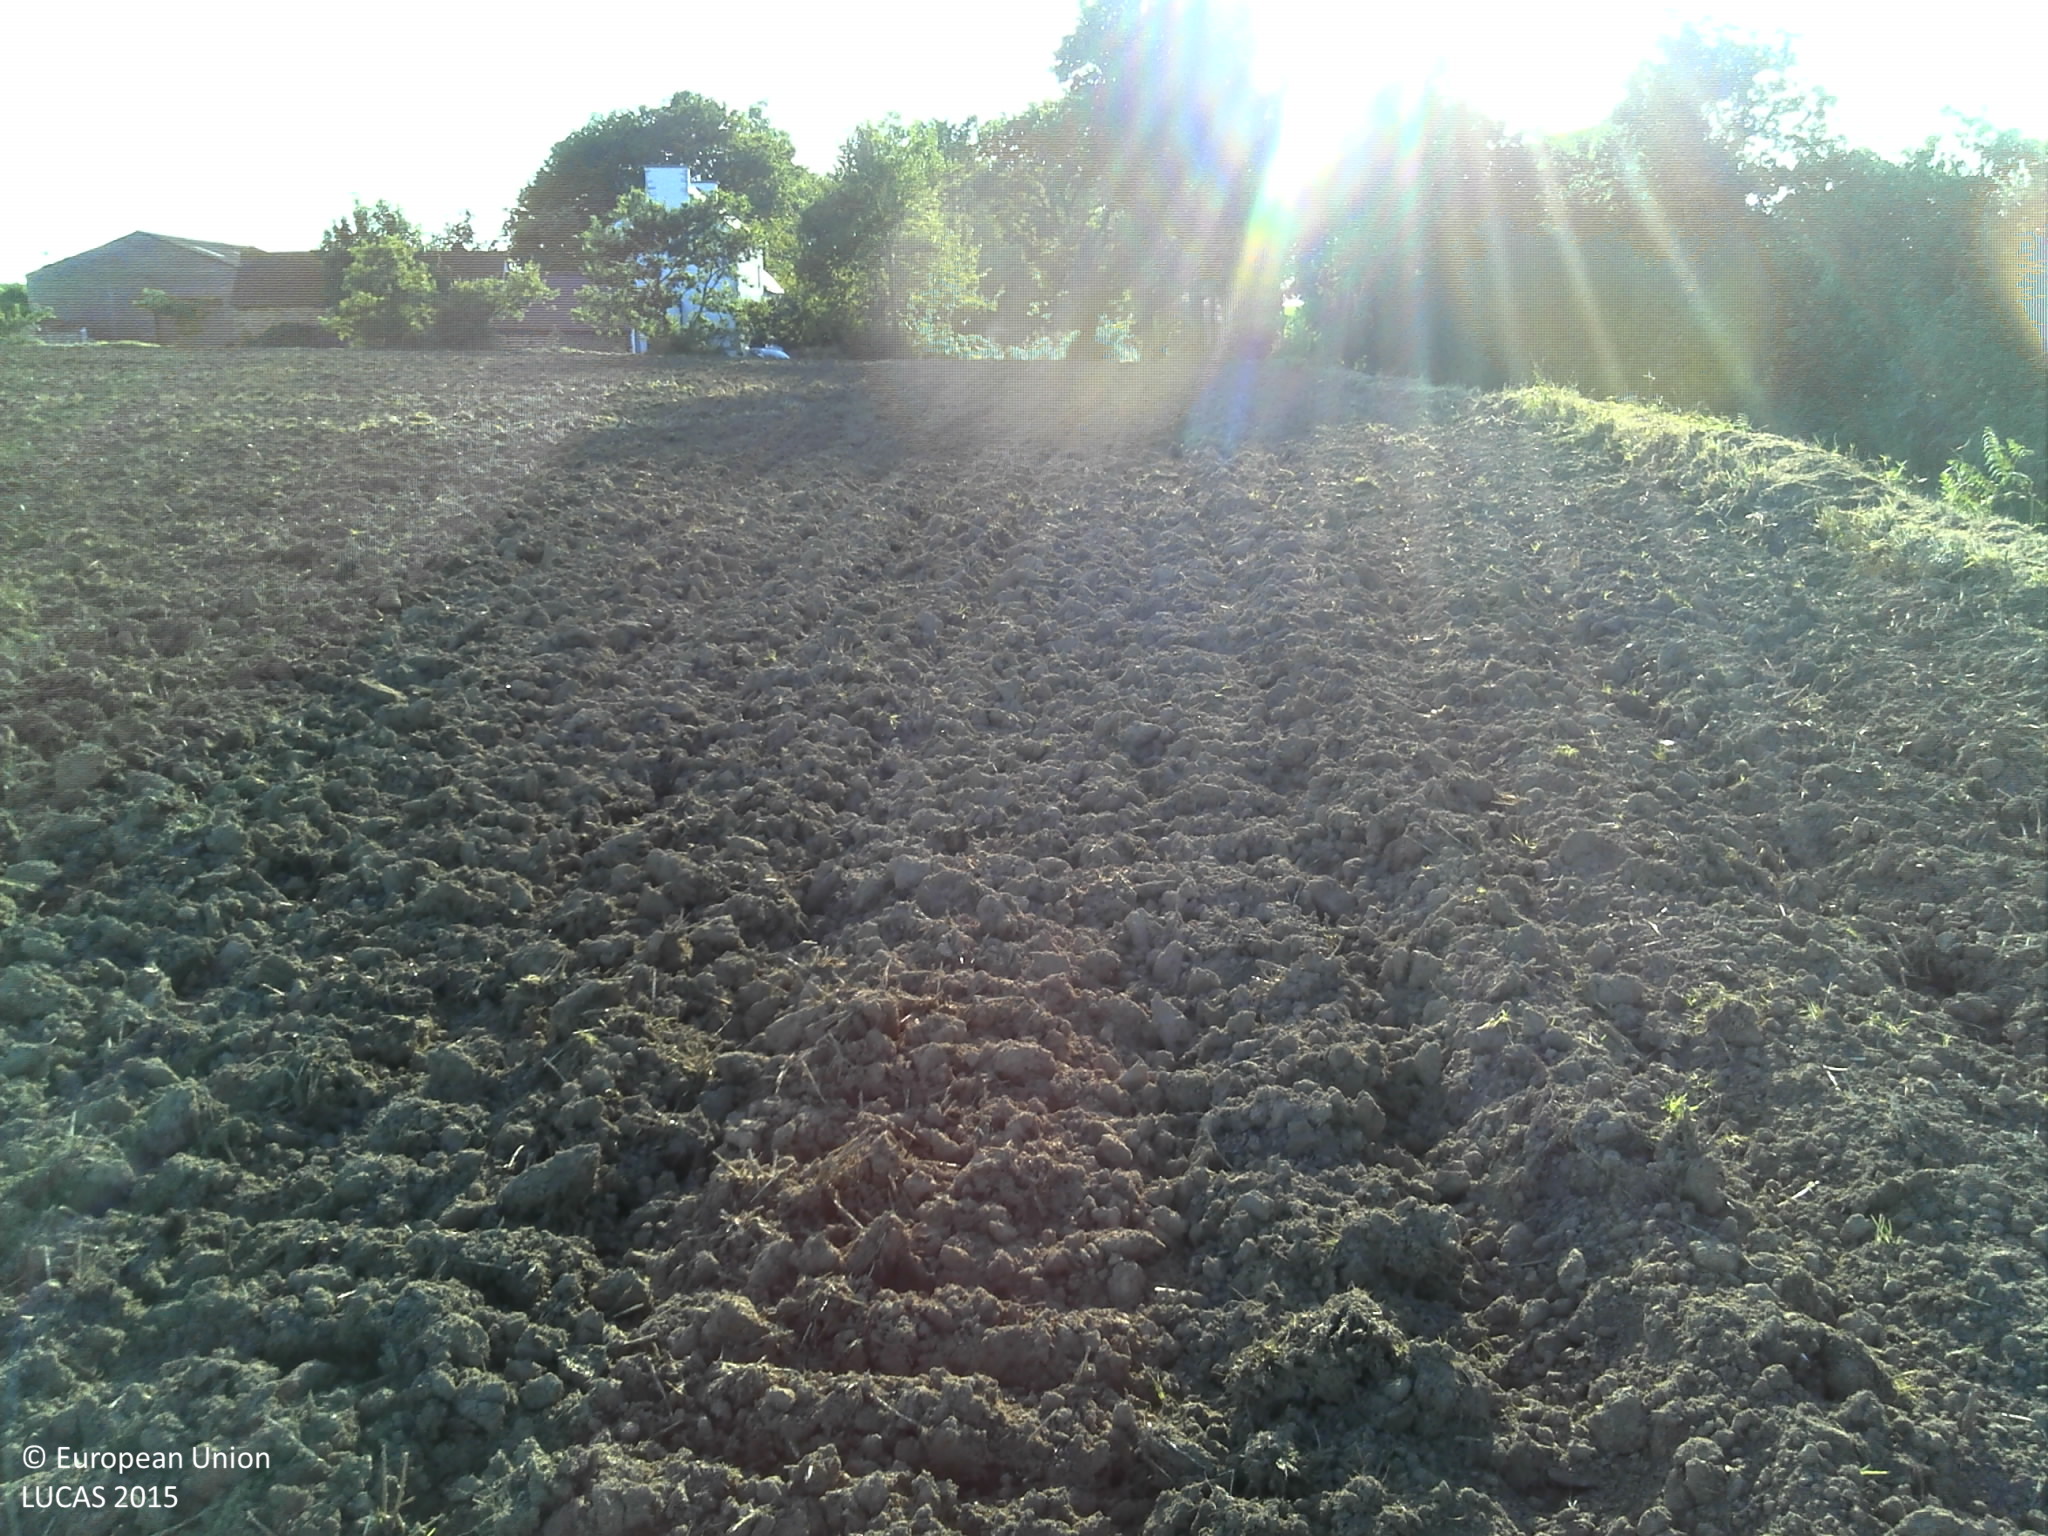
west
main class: Cropland
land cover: Barley
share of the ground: < 10 %
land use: Agriculture (excluding fallow land and kitchen gardens)
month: July
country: FR
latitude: 48.5032
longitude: -4.4860
